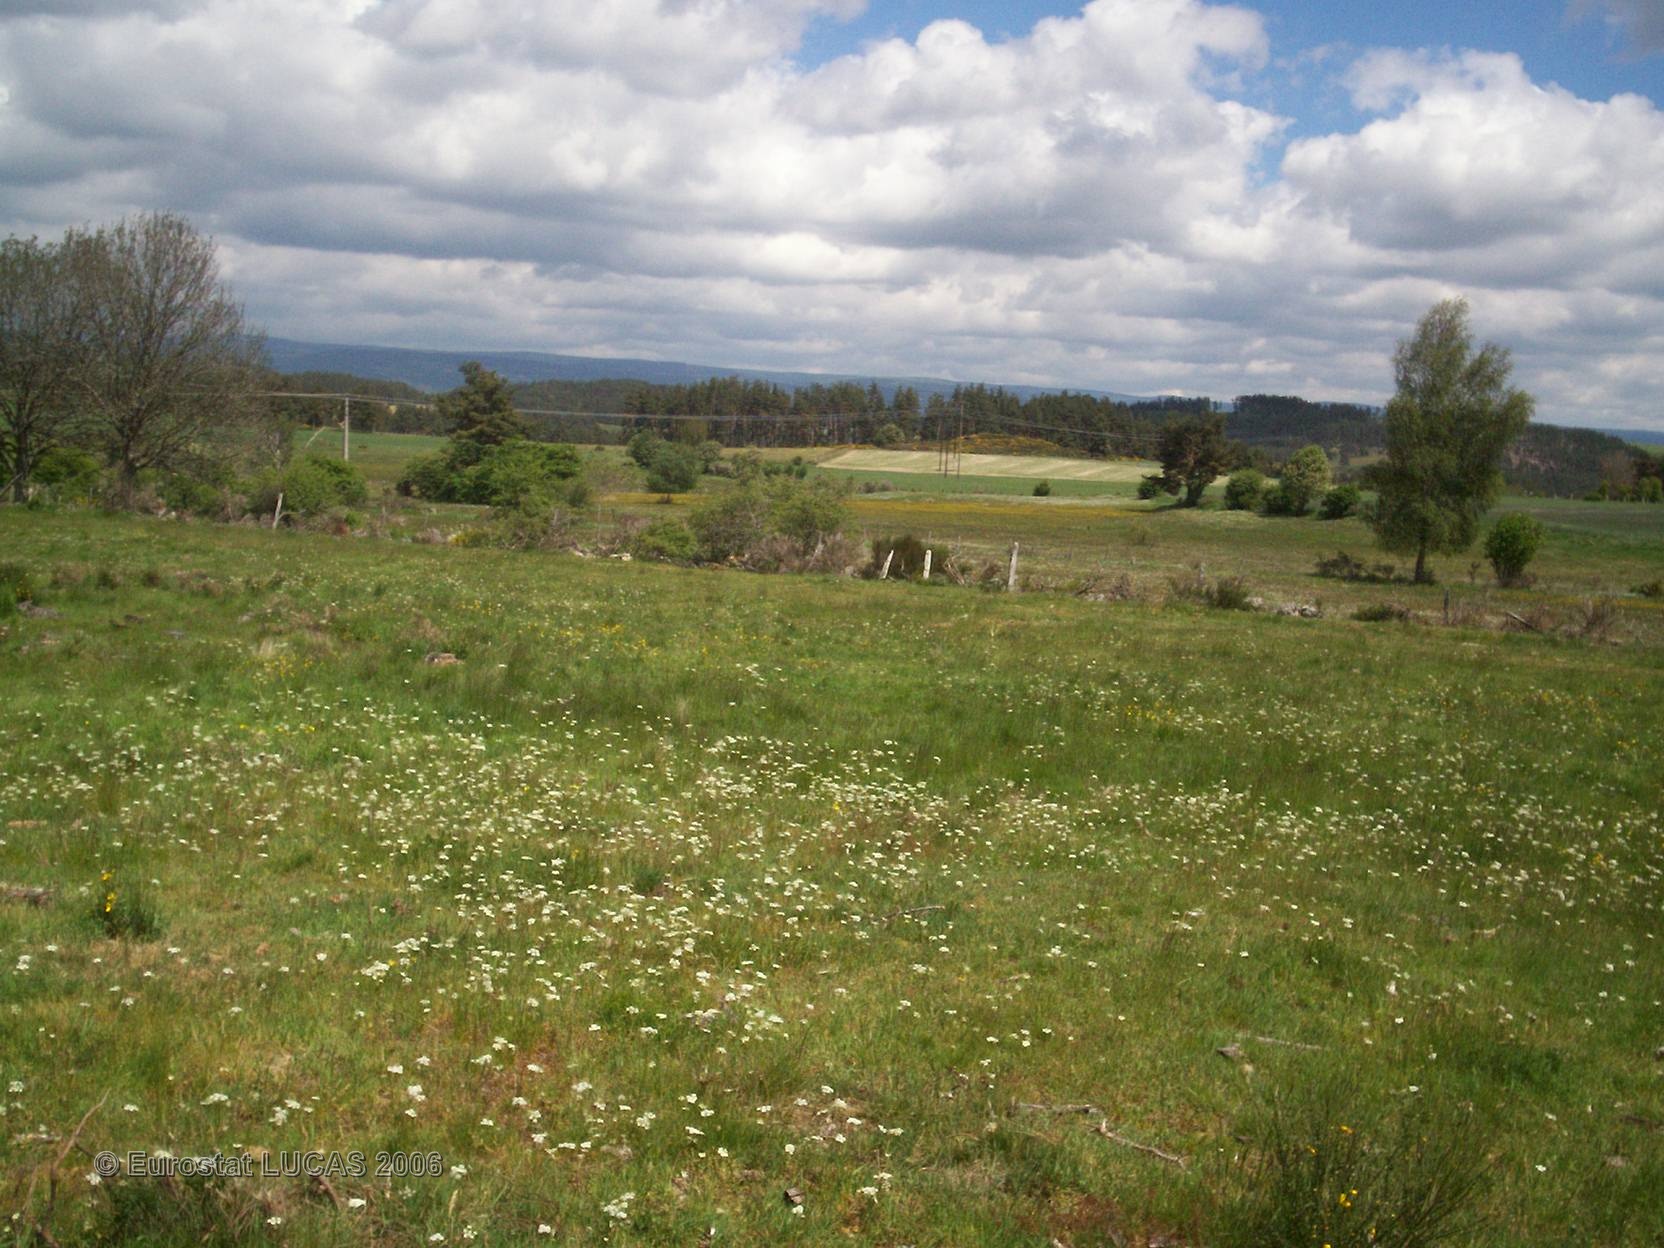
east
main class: Grassland
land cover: Grassland without tree/shrub cover
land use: Agriculture (excluding fallow land and kitchen gardens)
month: May
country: FR
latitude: 44.7667
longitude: 3.2948
